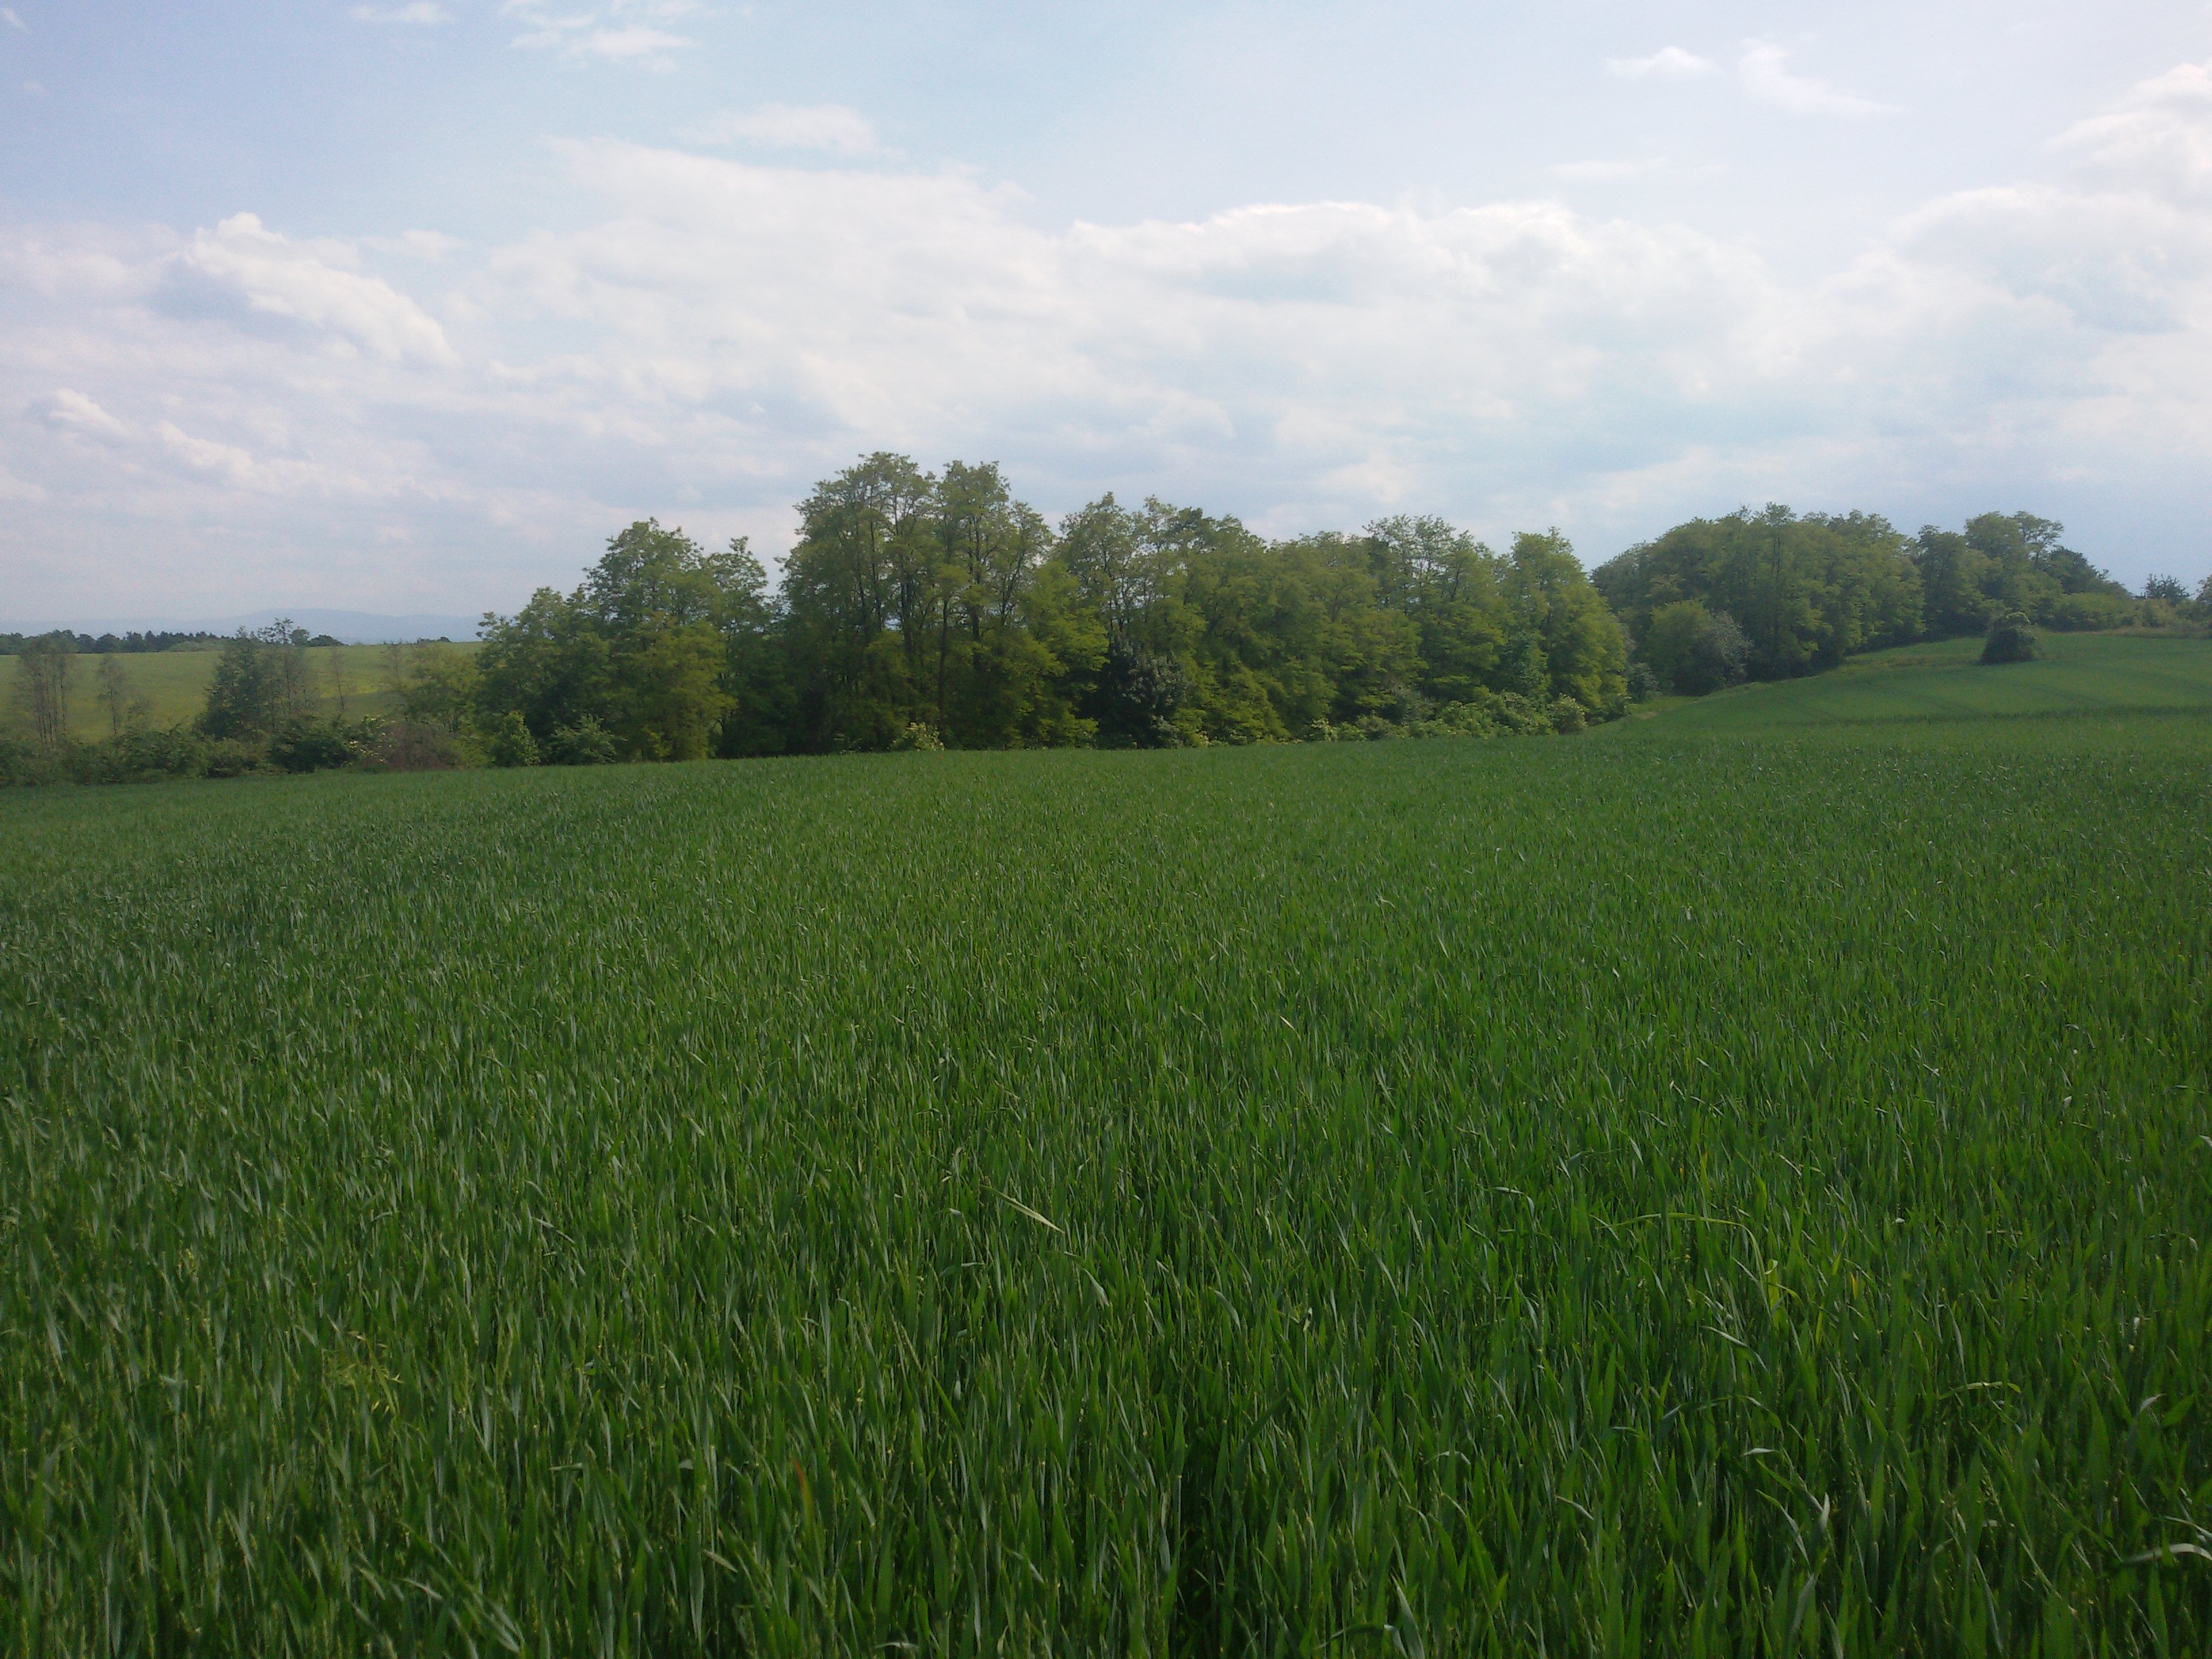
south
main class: Cropland
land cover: Common wheat
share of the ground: > 75 %
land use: Agriculture (excluding fallow land and kitchen gardens)
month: May
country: PL
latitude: 50.5347
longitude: 17.1923
